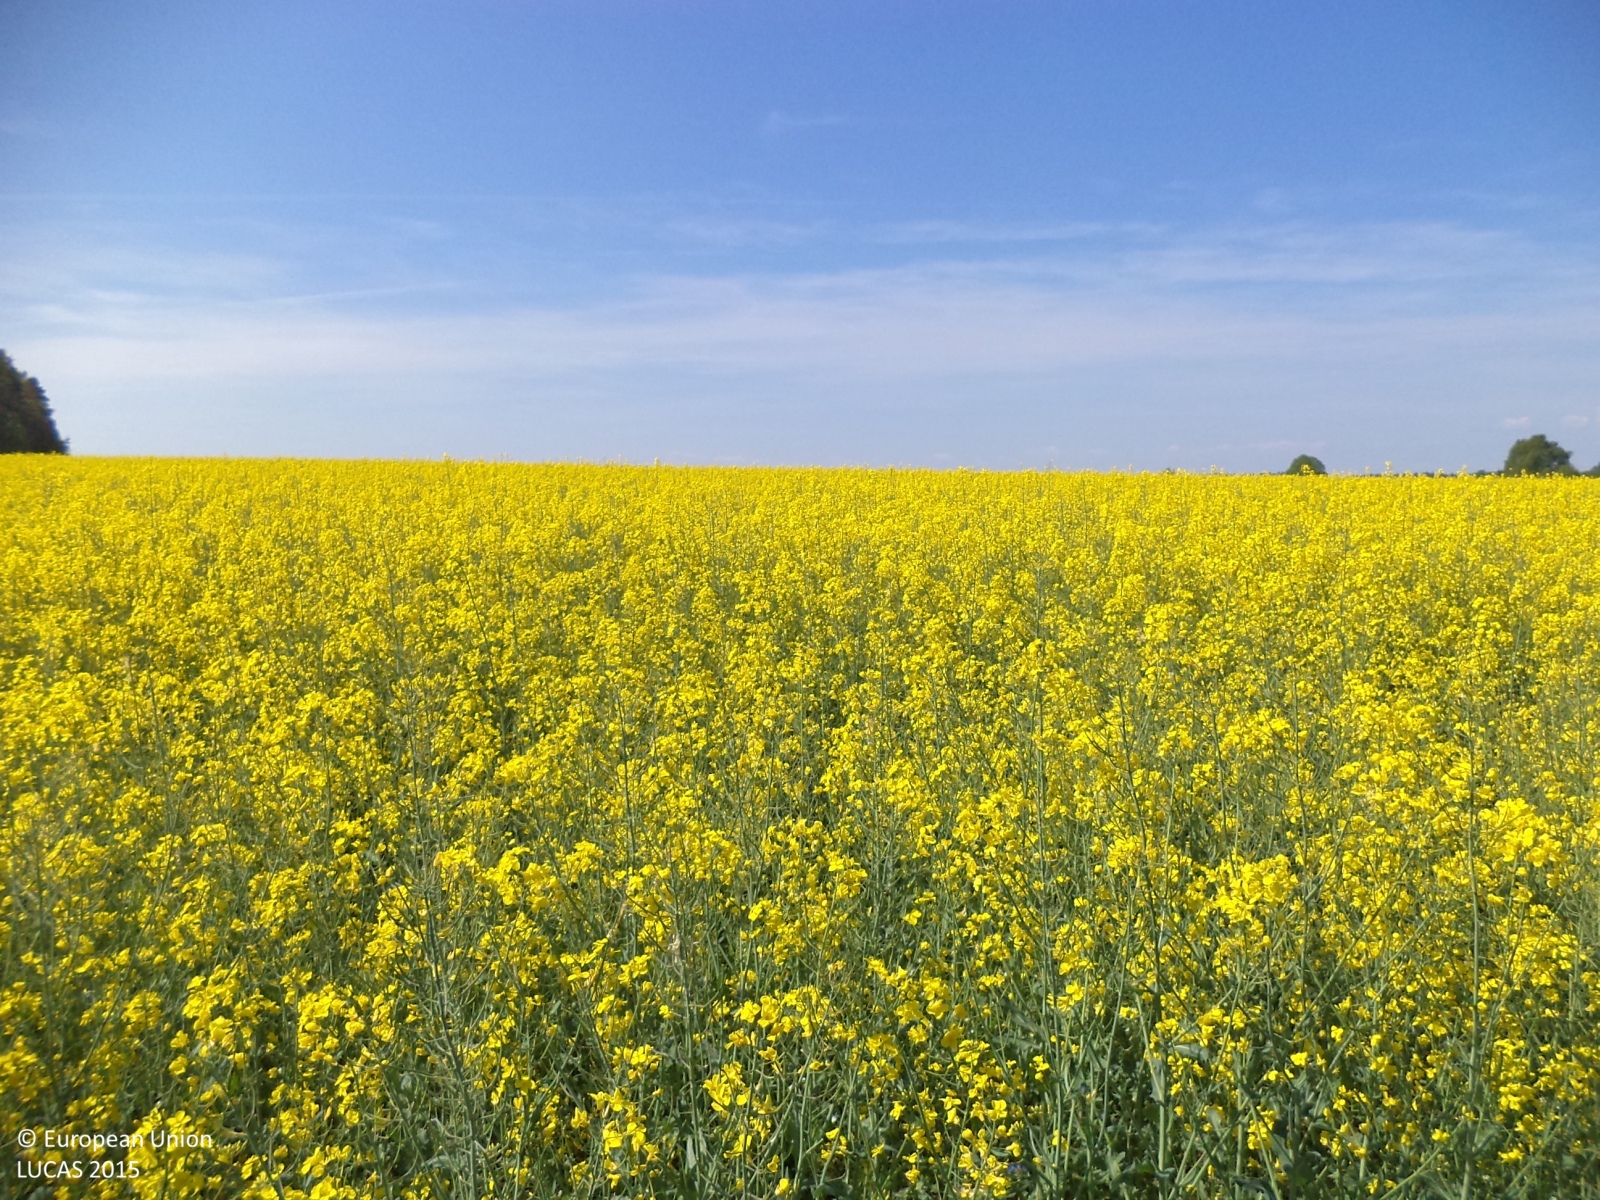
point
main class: Cropland
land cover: Rape and turnip rape
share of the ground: > 75 %
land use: Agriculture (excluding fallow land and kitchen gardens)
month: May
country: CZ
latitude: 49.2499
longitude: 14.9065
